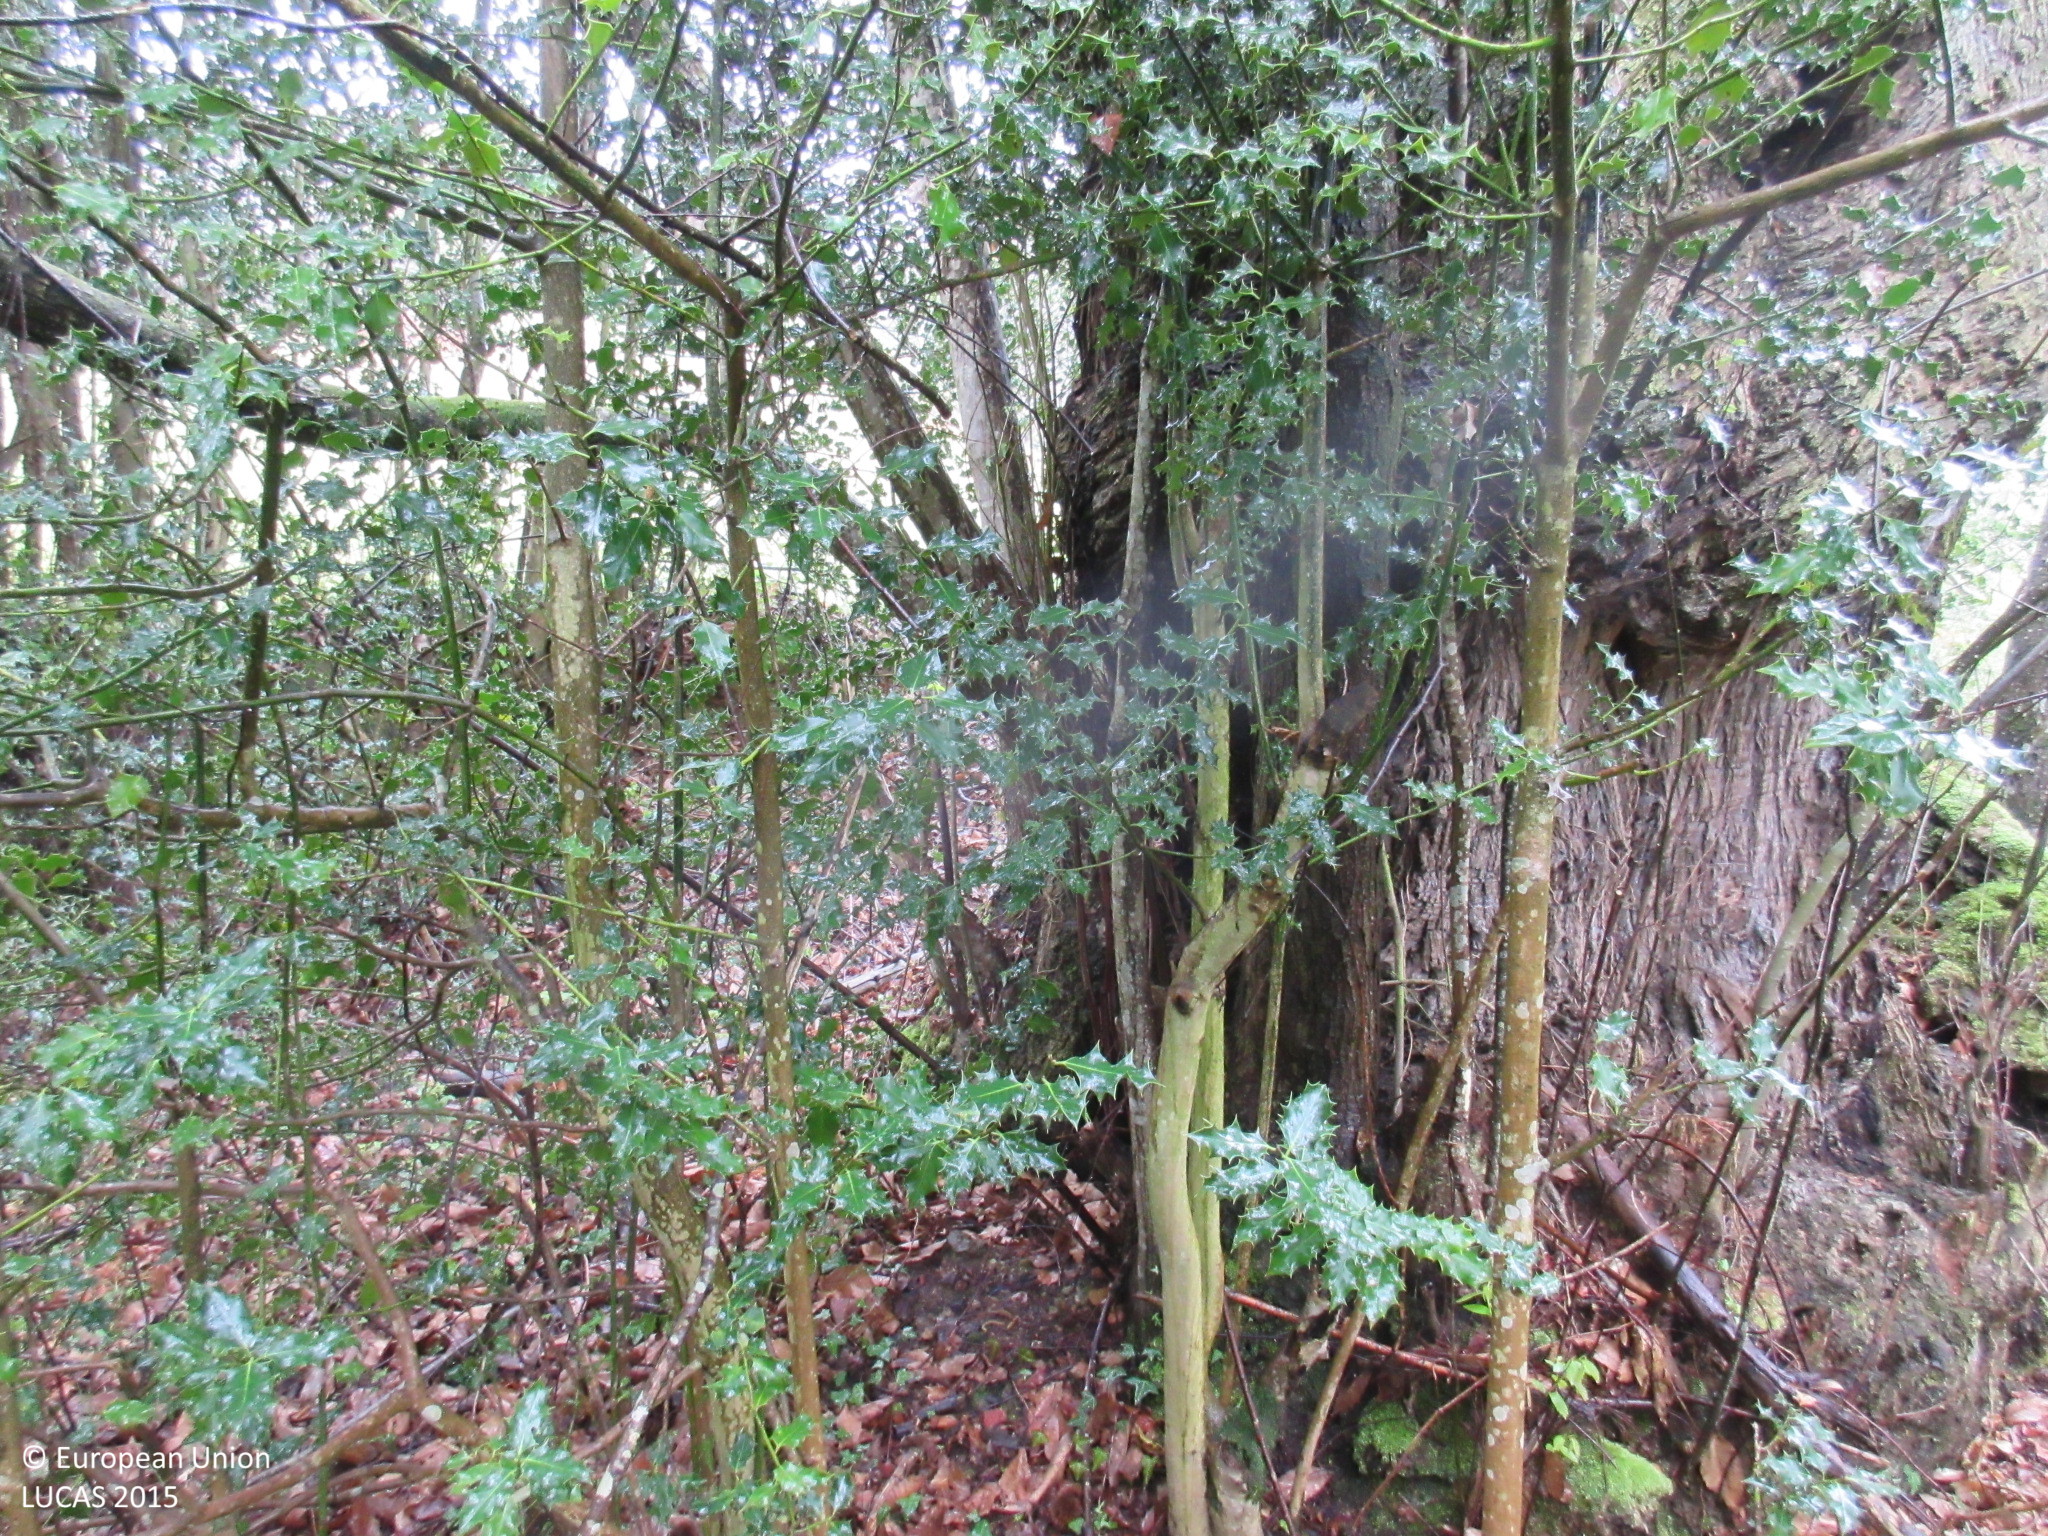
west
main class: Woodland
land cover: Broadleaved woodland
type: acidophilous oak and oak-birch forest
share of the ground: > 75 %
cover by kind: broadleaved forest trees 100 %
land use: Forestry
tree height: > 5 m
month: April
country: ES
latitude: 43.4481
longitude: -5.2879
